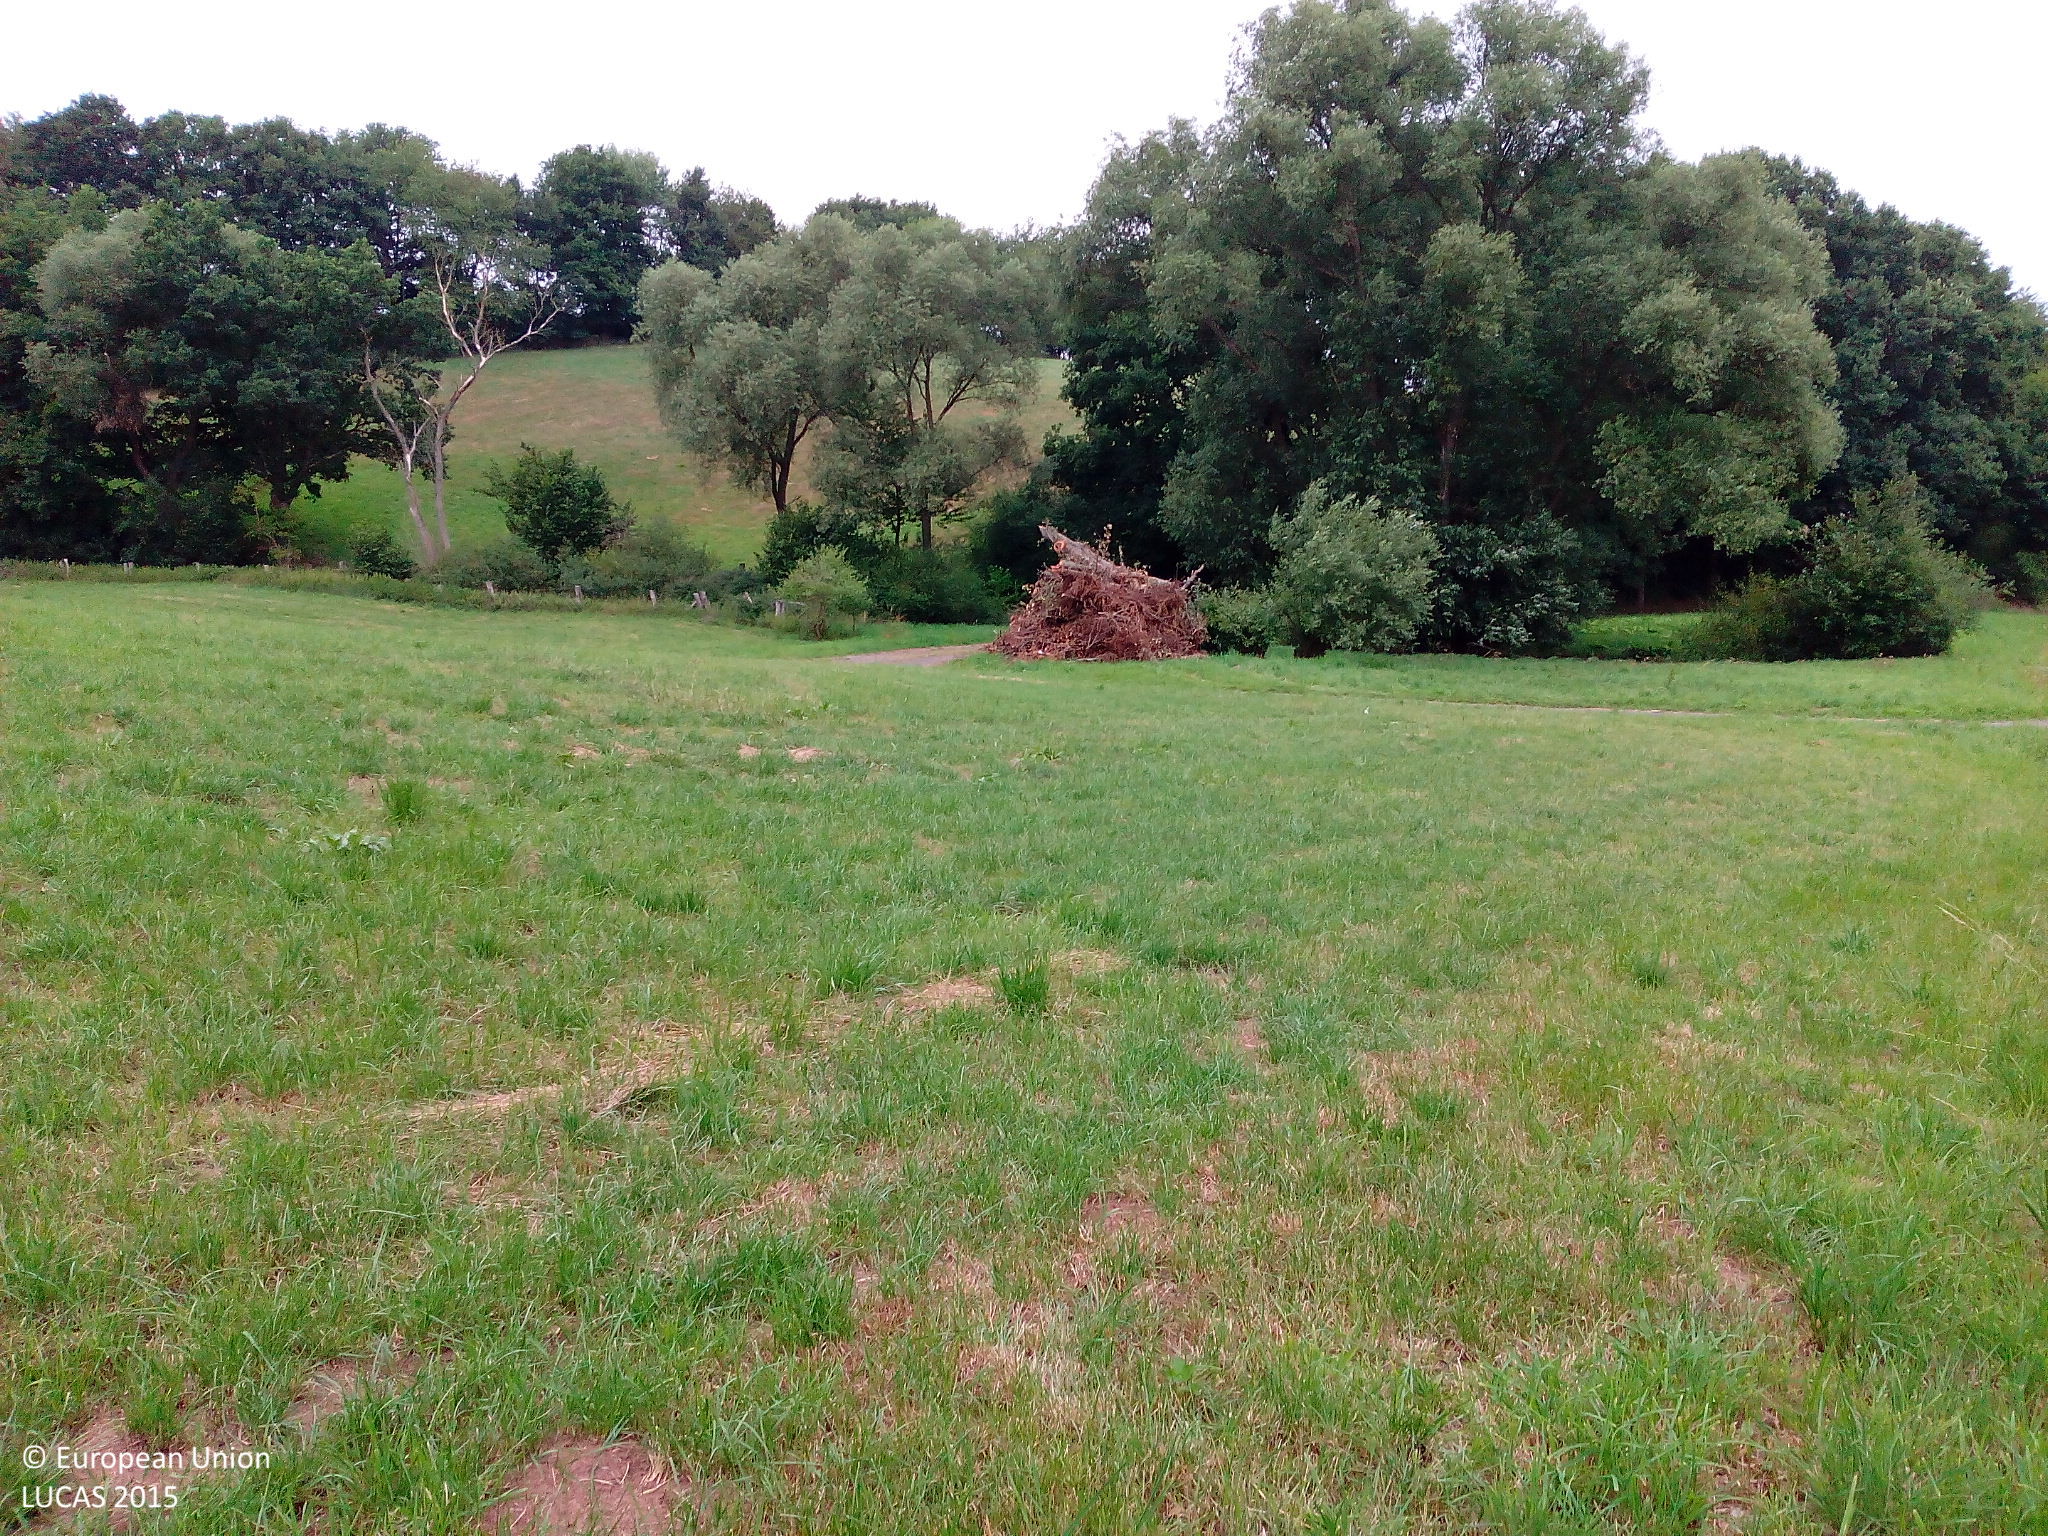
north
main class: Grassland
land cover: Grassland without tree/shrub cover
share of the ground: > 75 %
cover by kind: herbaceous plants 100 %
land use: Agriculture (excluding fallow land and kitchen gardens)
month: July
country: DE
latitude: 50.8315
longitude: 9.9290
